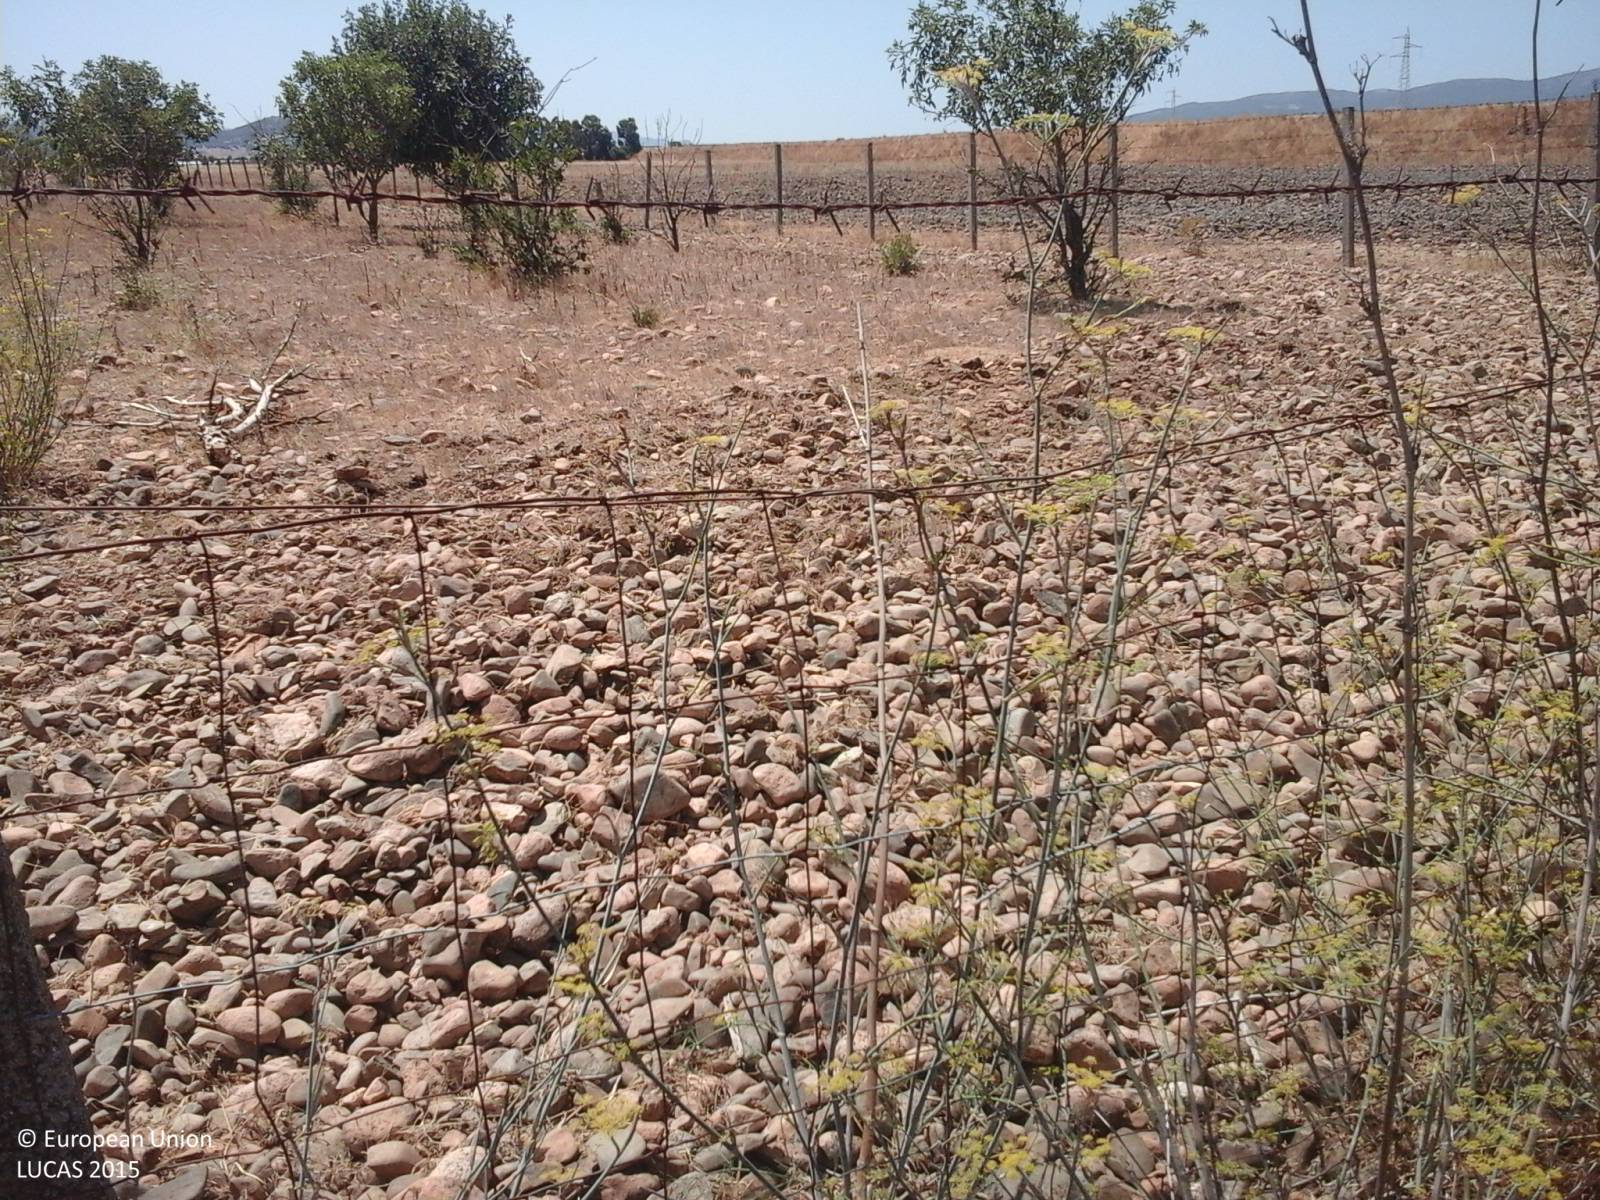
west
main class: Woodland
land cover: Broadleaved woodland
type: thermophilous deciduous forest
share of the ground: > 75 %
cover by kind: broadleaved forest trees 100 %
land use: Forestry
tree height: < 5 m
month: August
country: IT
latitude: 39.3734
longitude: 8.8808
